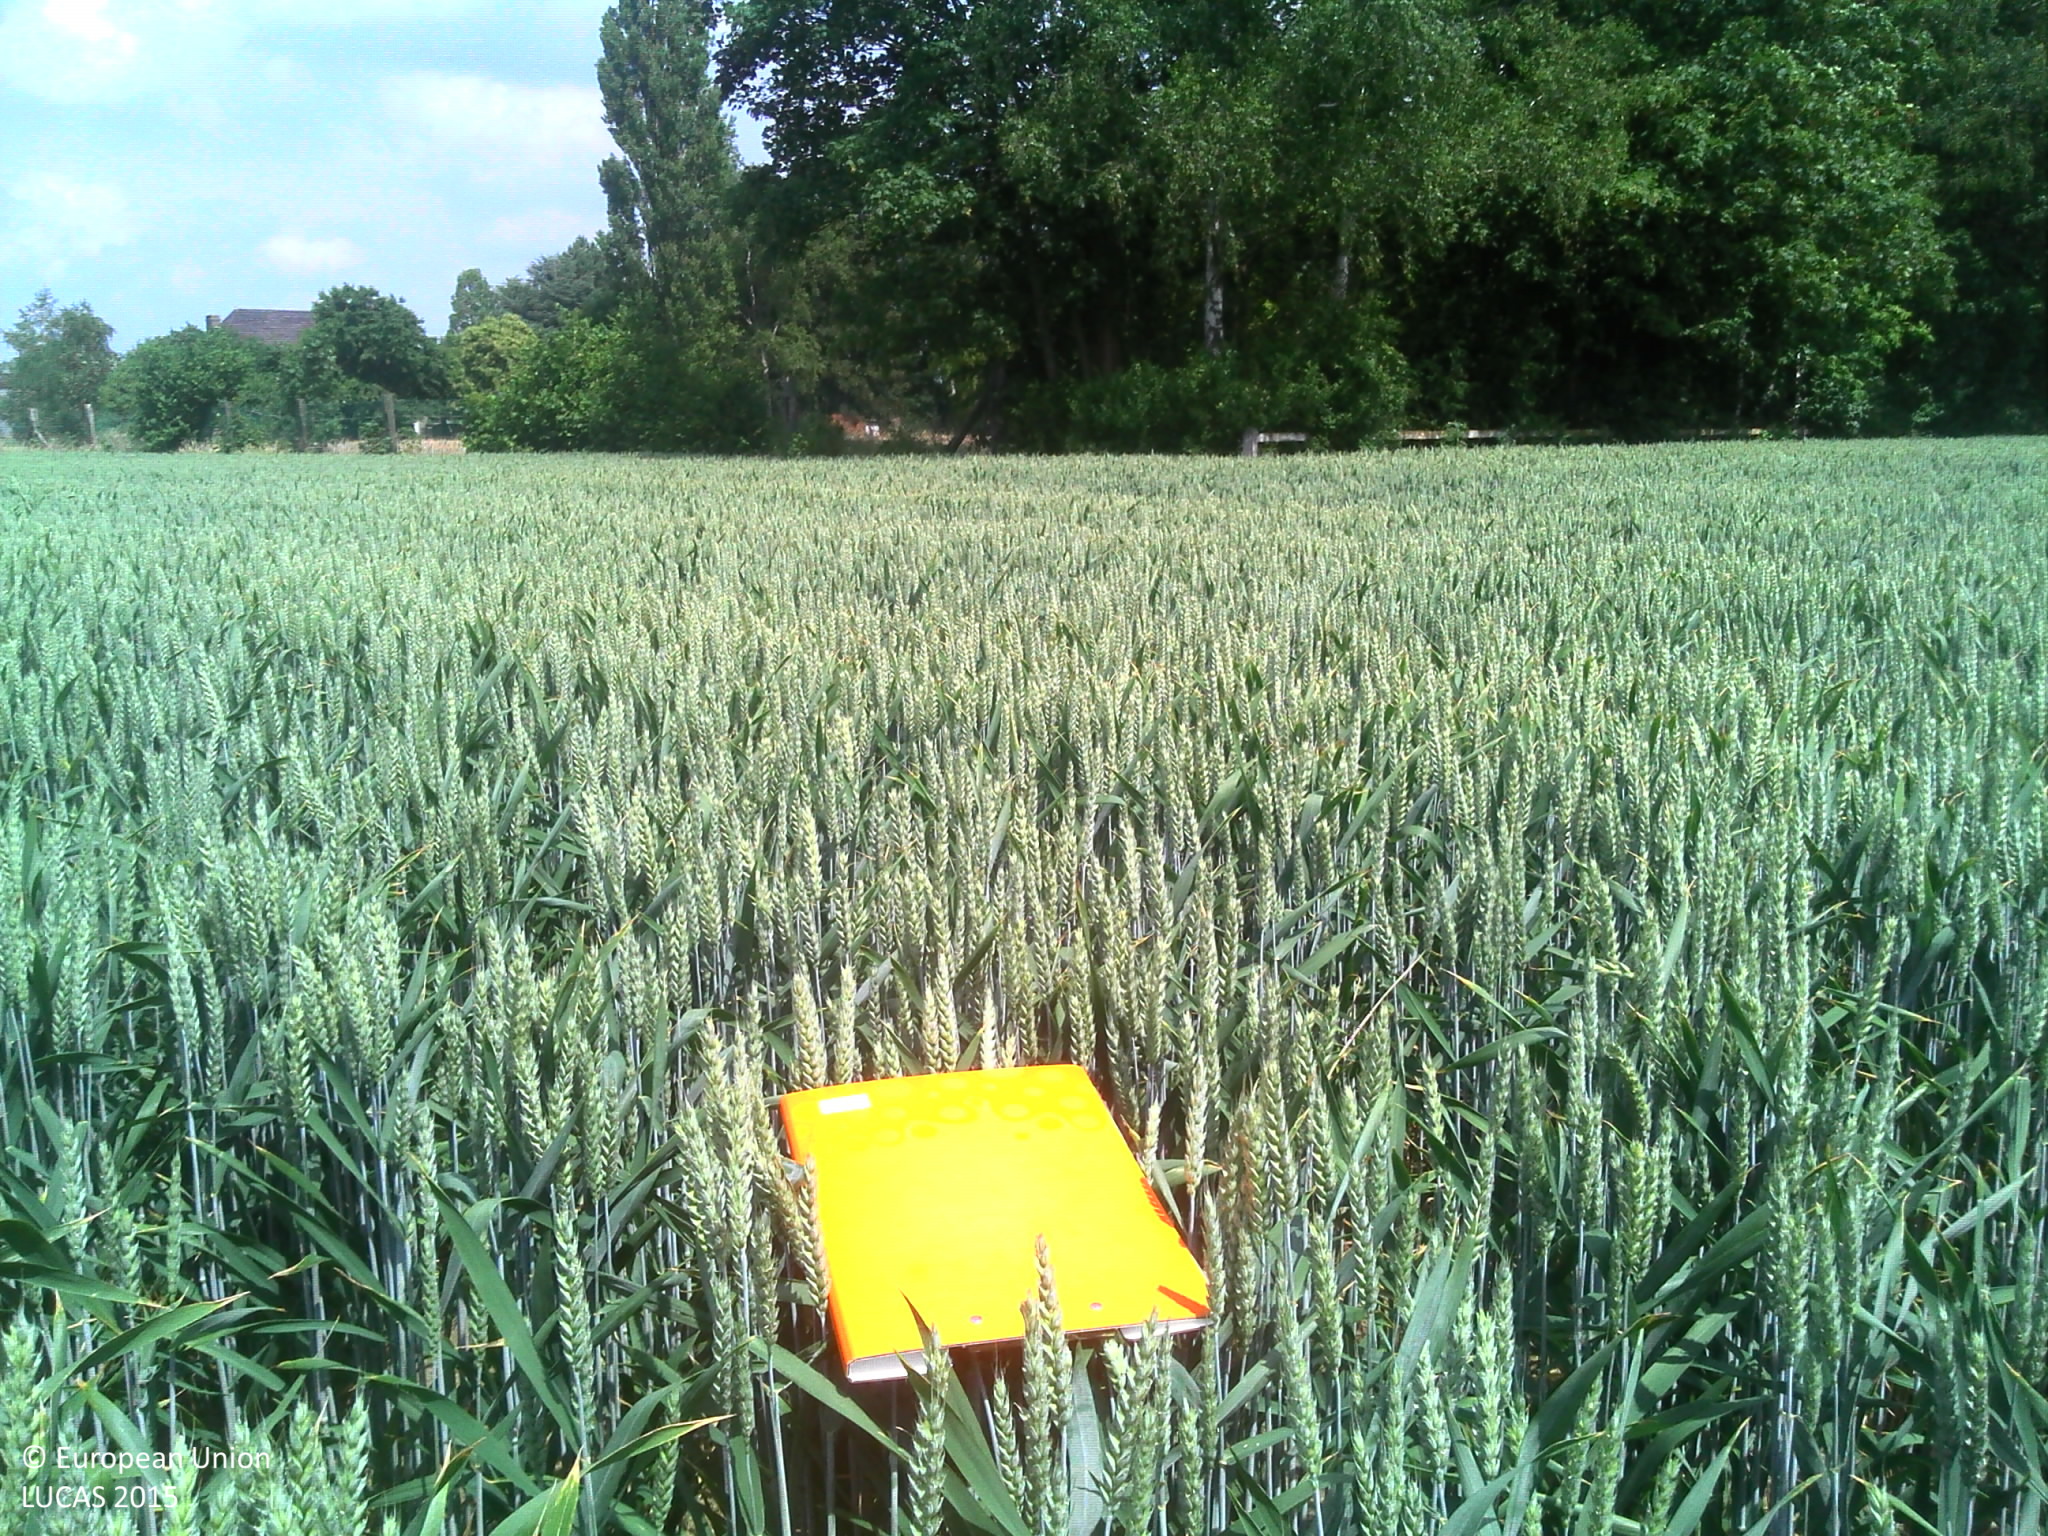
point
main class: Cropland
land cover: Common wheat
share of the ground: > 75 %
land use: Agriculture (excluding fallow land and kitchen gardens)
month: June
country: BE
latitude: 50.9368
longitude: 4.5457
